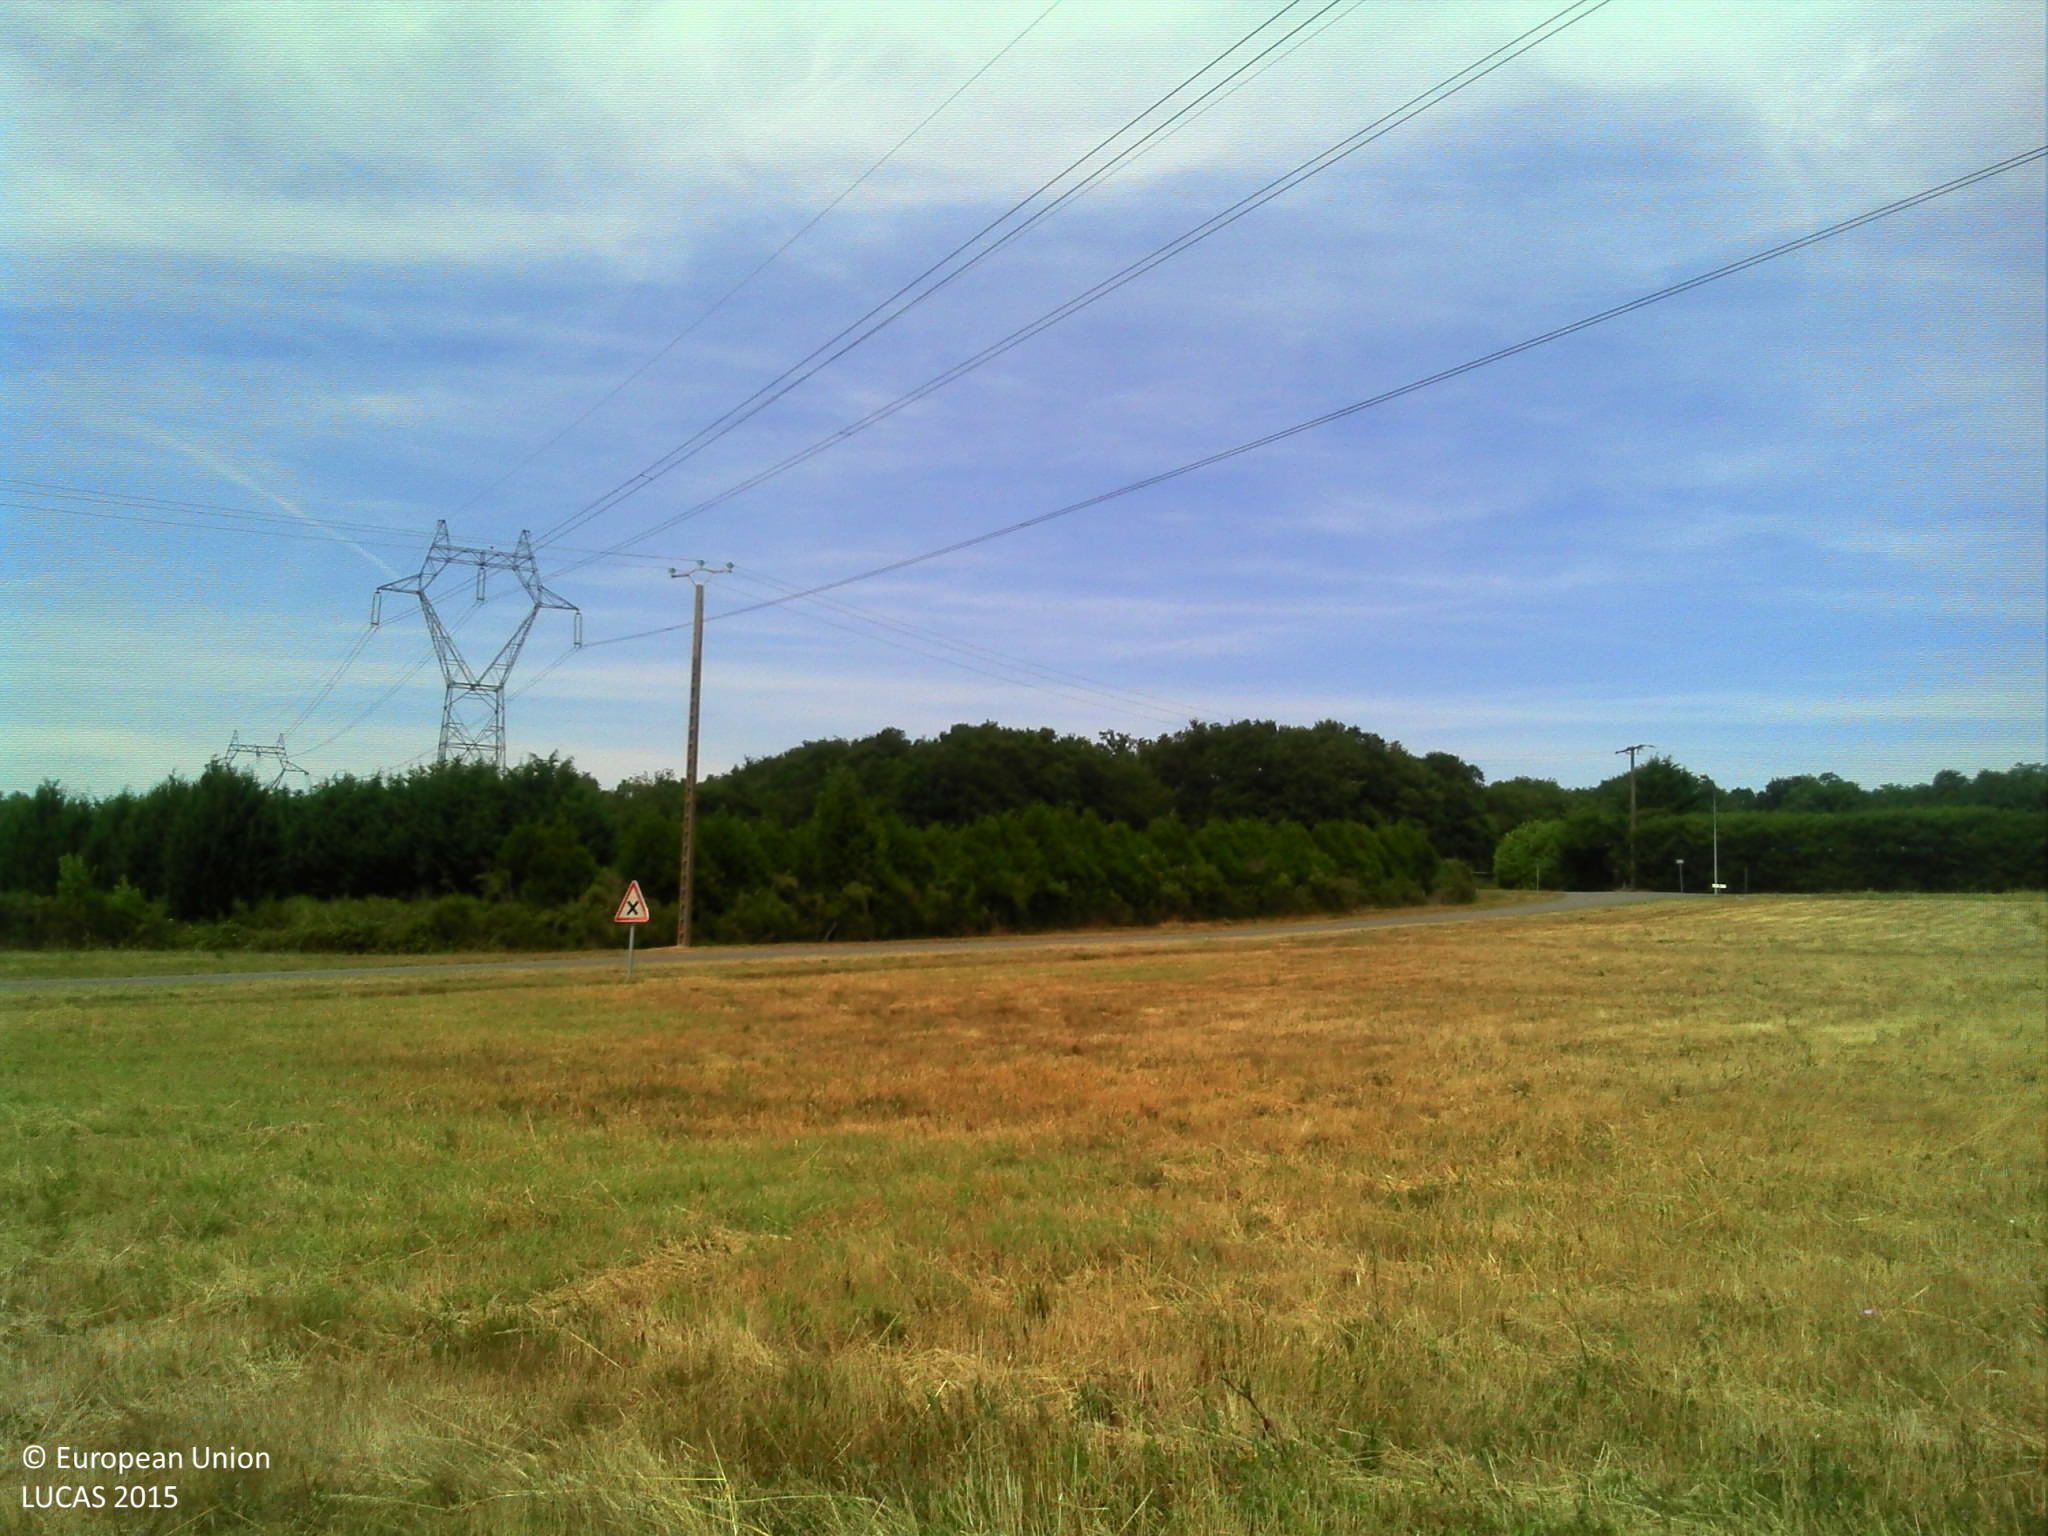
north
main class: Grassland
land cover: Grassland without tree/shrub cover
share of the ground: > 75 %
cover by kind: herbaceous plants 100 %
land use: Agriculture (excluding fallow land and kitchen gardens)
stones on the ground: < 10 %
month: June
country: FR
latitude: 47.7355
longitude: 2.5373
